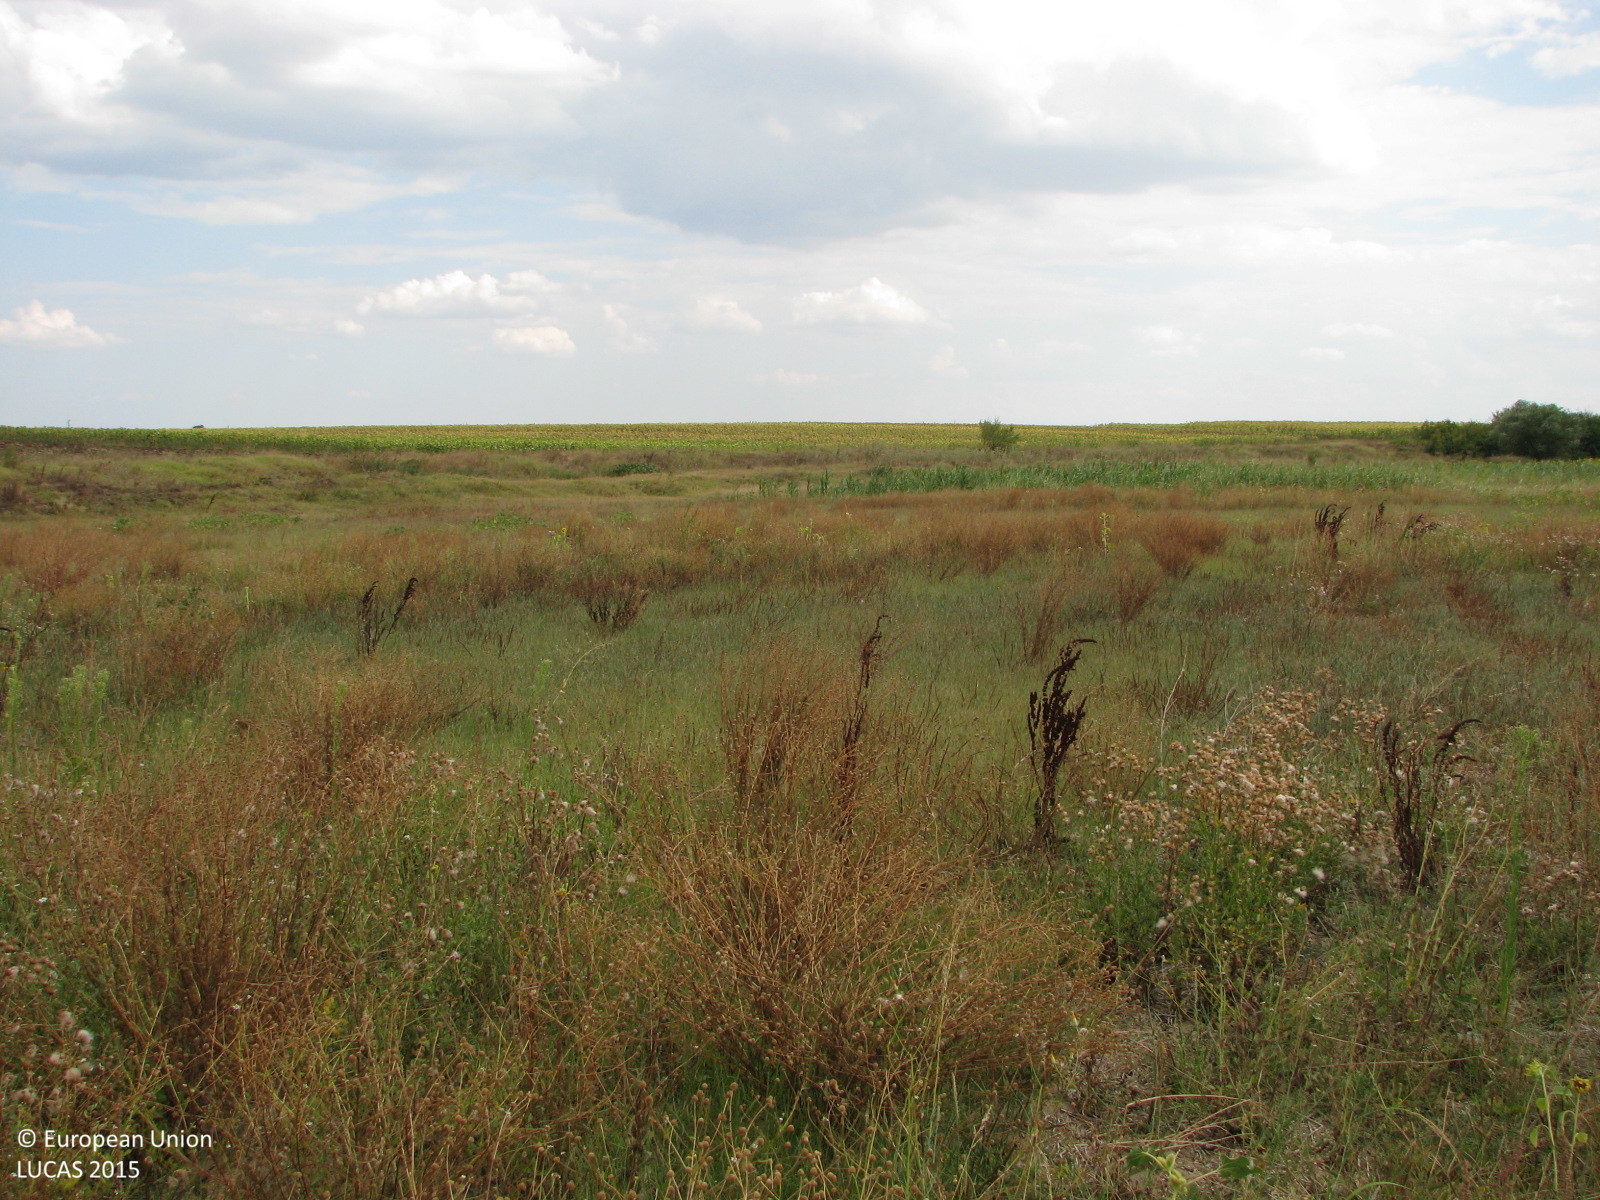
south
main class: Grassland
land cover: Spontaneously vegetated surfaces
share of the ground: > 75 %
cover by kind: herbaceous plants 100 %
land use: Fallow land
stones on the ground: < 10 %
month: August
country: BG
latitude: 42.4242
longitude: 26.5364
